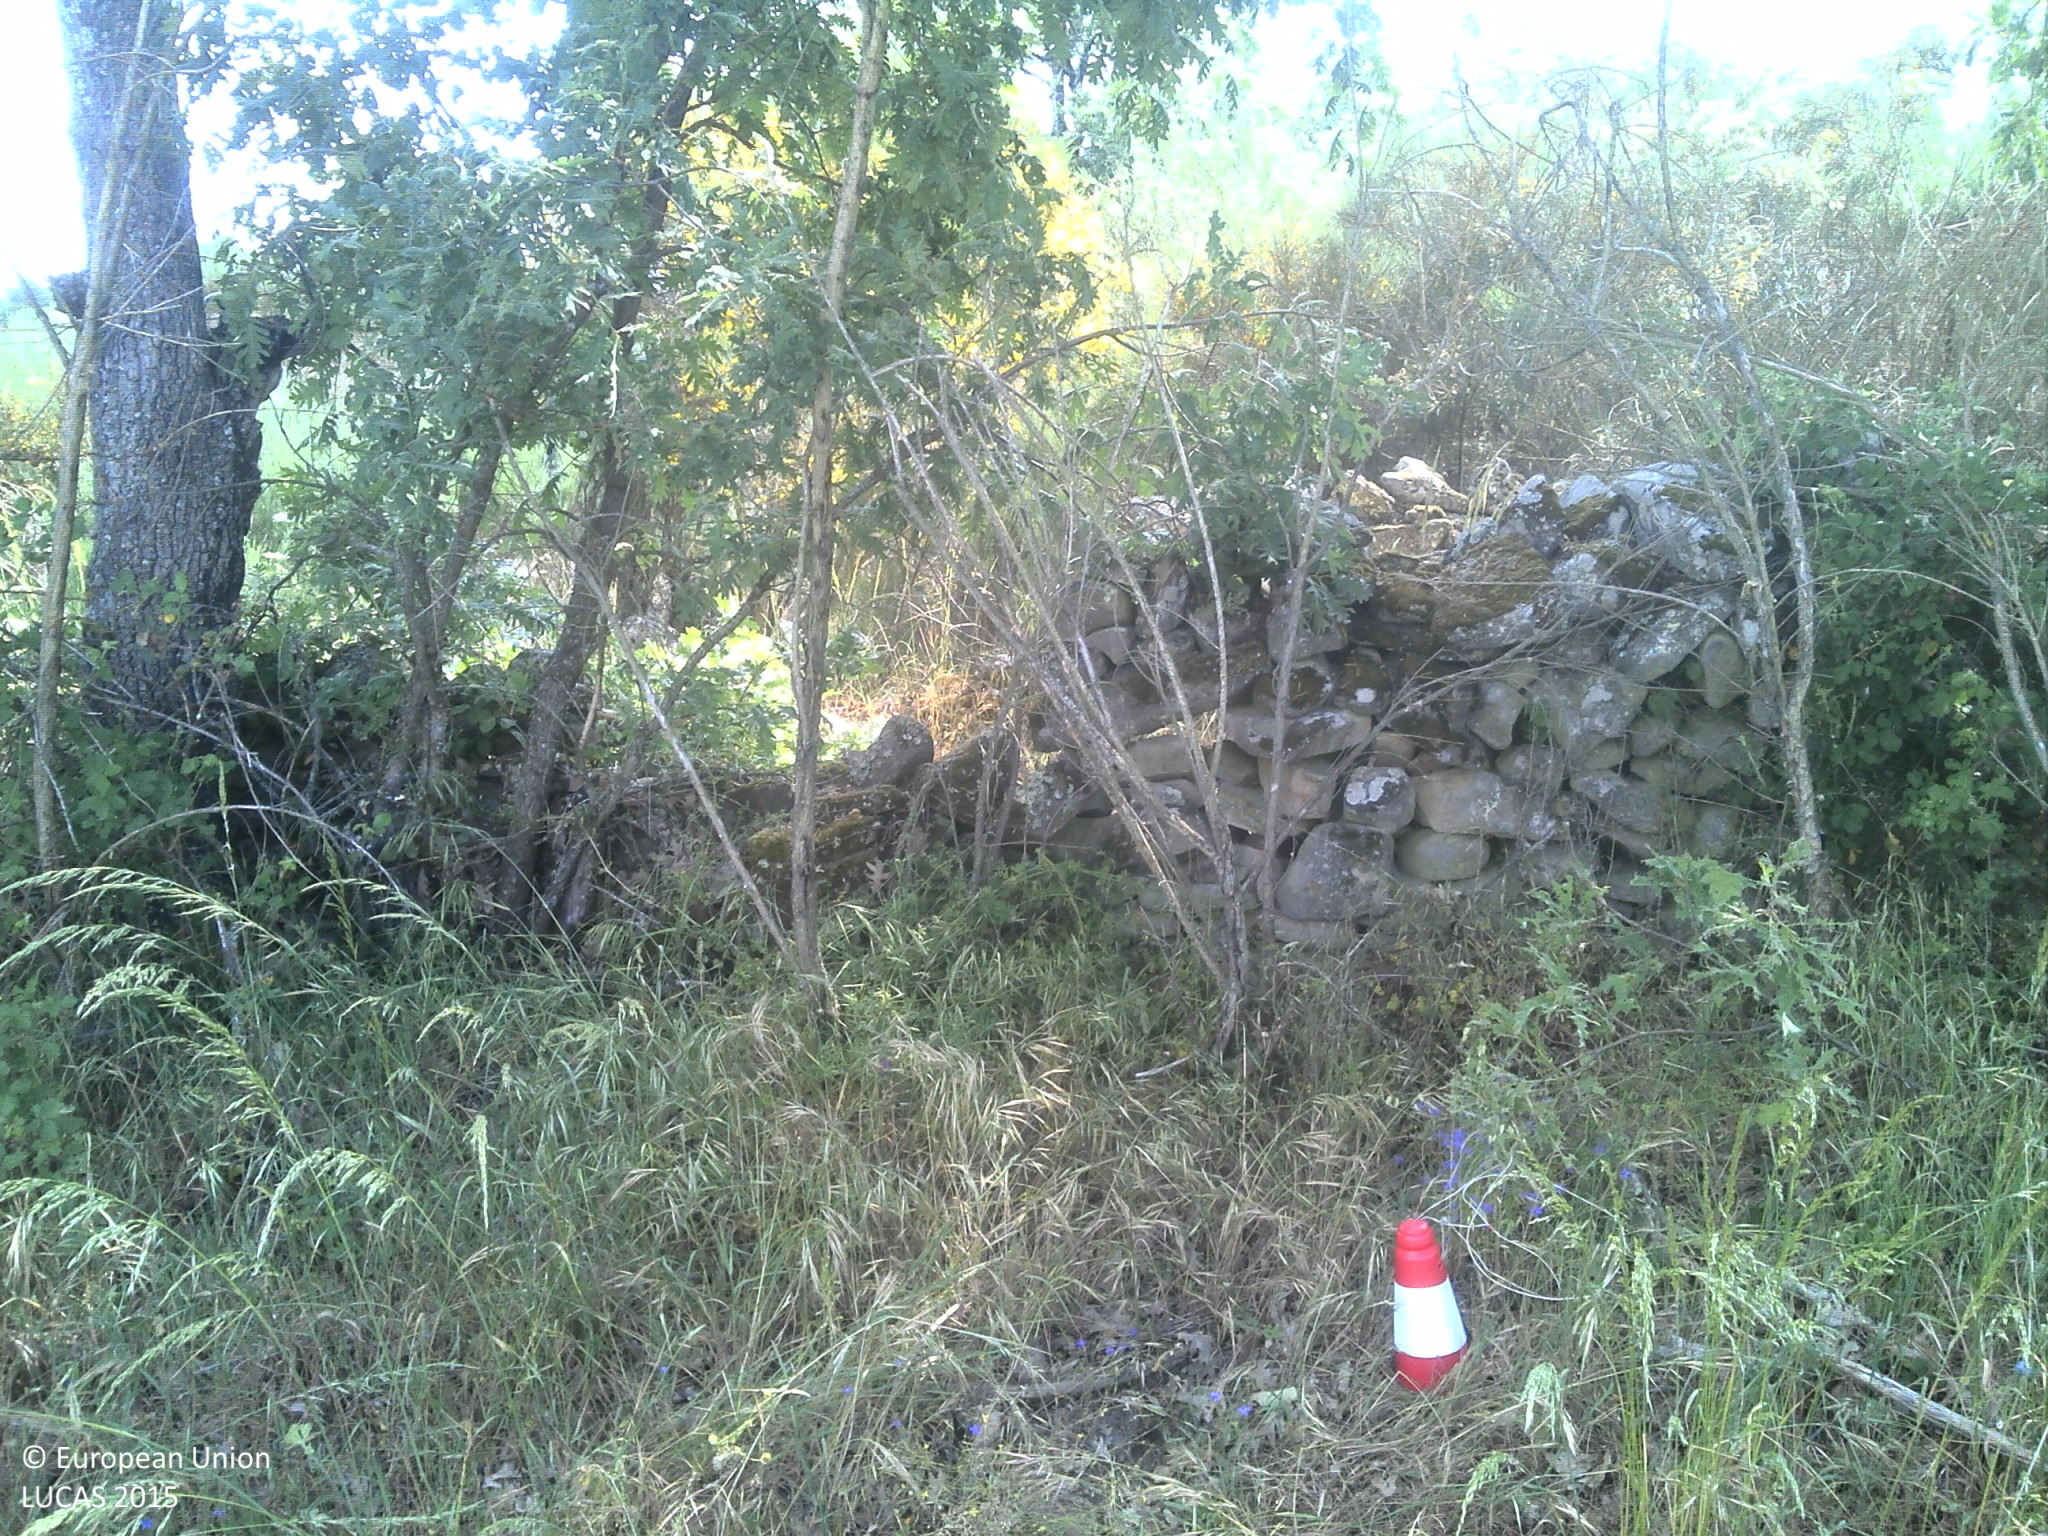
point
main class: Grassland
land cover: Grassland without tree/shrub cover
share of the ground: 50 - 75 %
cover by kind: herbaceous plants 75 %, unconsolidated bare surface 20 %, shrubs 5 %
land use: Agriculture (excluding fallow land and kitchen gardens)
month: June
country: PT
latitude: 40.5002
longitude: -7.1290
